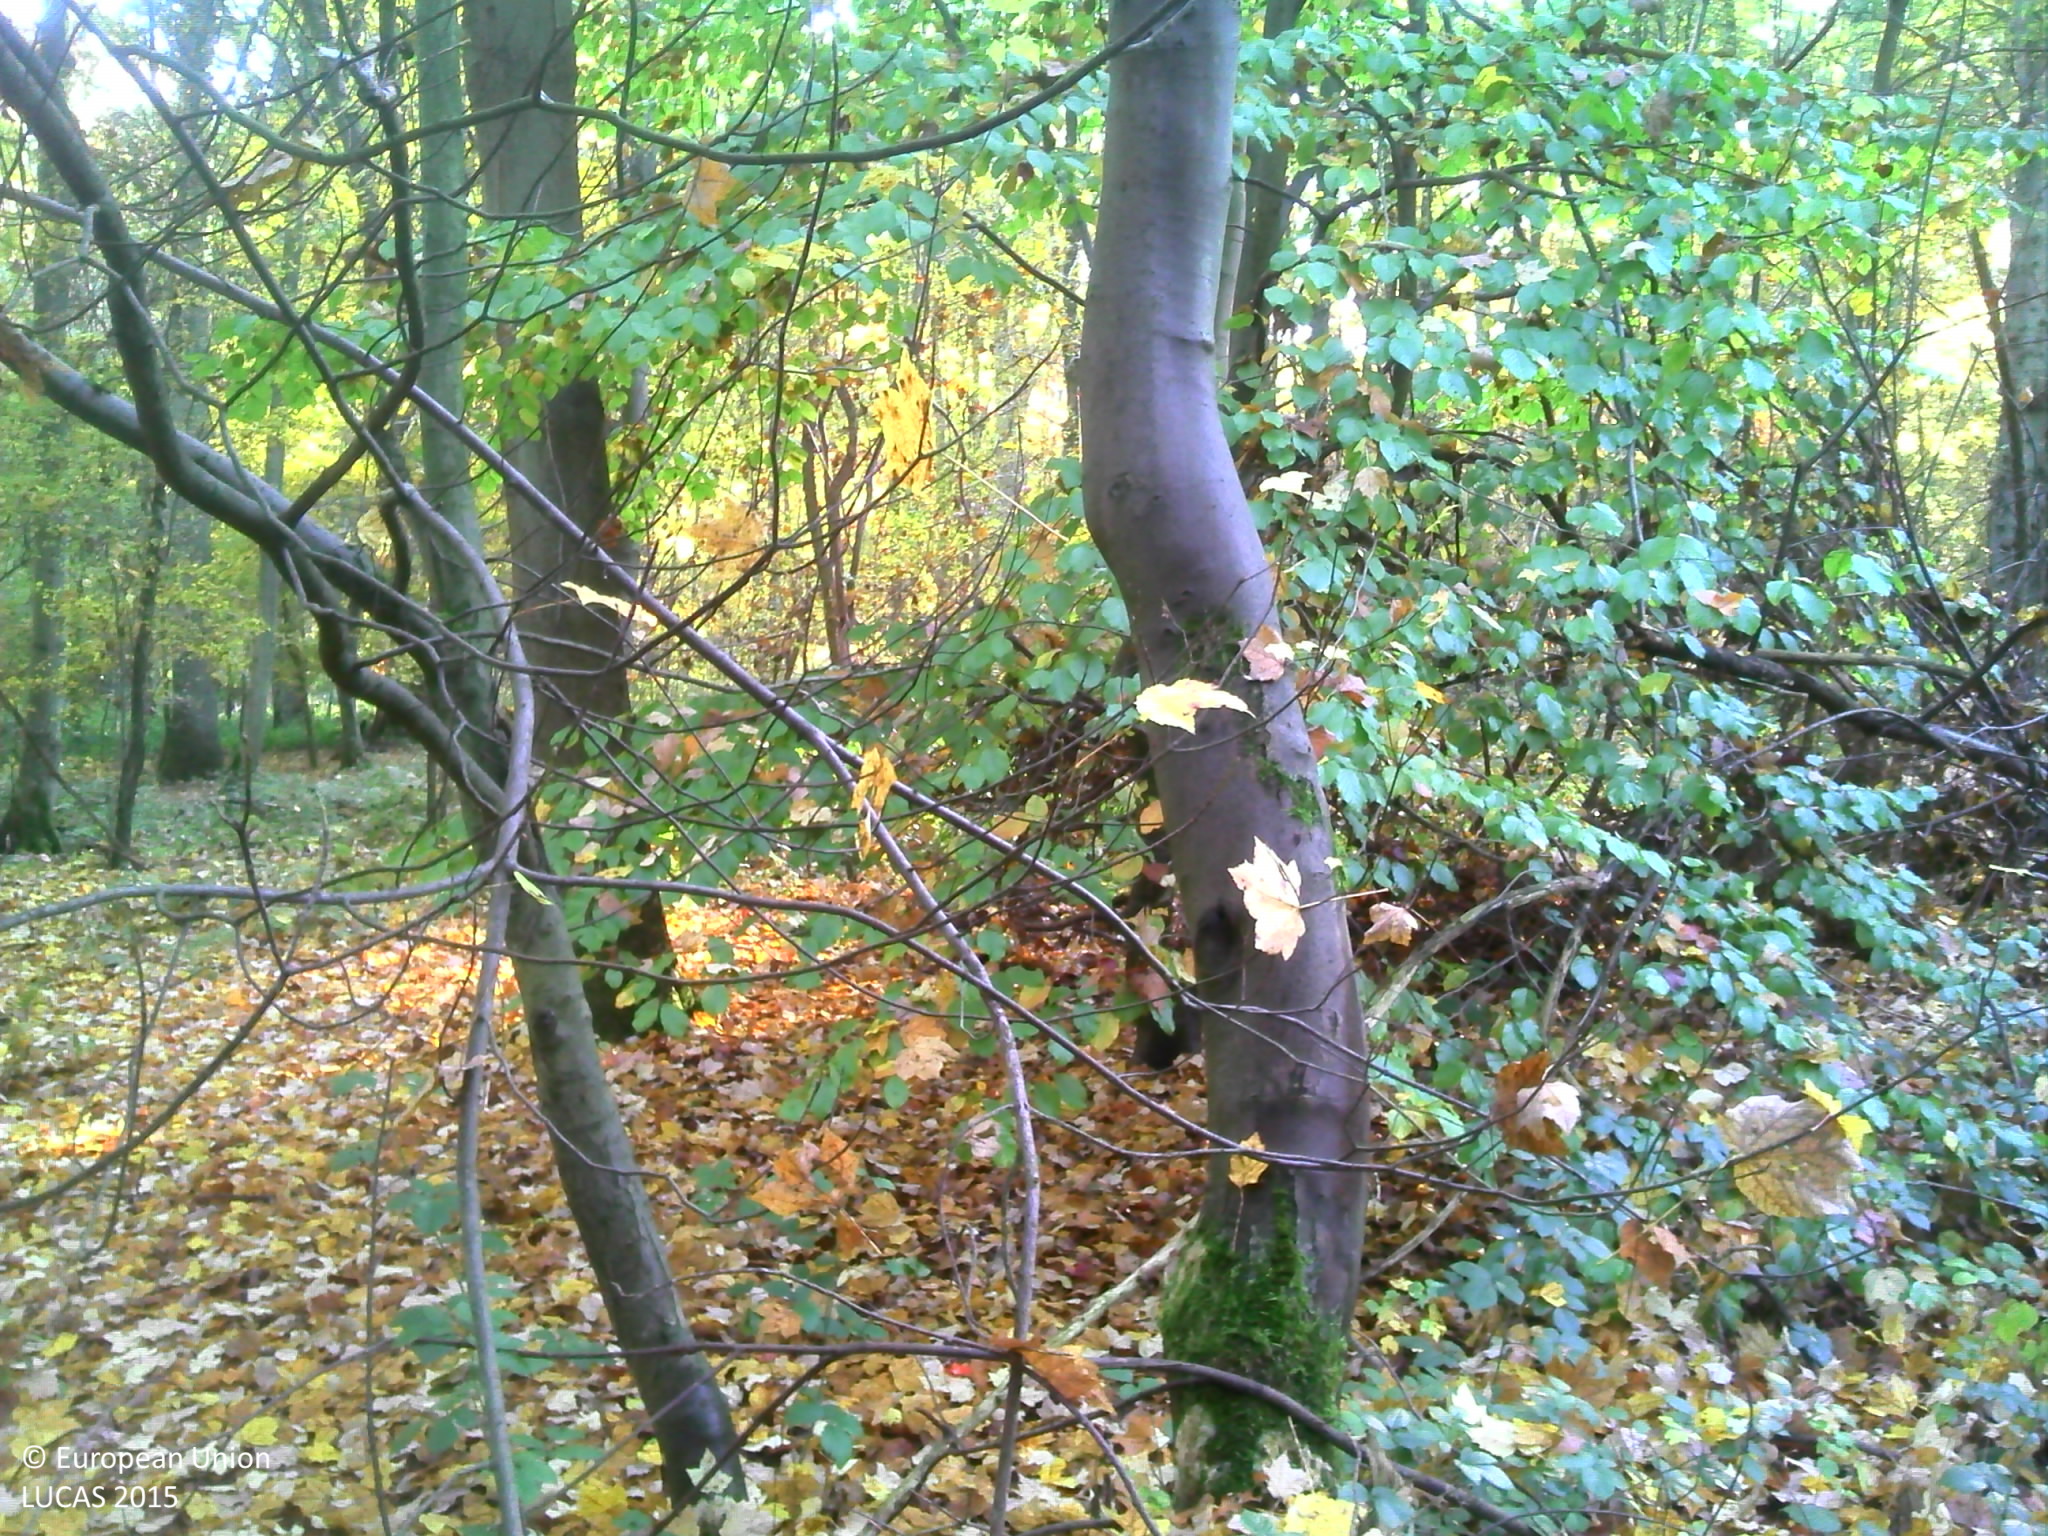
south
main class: Woodland
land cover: Broadleaved woodland
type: mesophytic deciduous forest
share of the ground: > 75 %
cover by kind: broadleaved forest trees 80 %, herbaceous plants 20 %
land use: Forestry
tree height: > 5 m
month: October
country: BE
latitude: 50.8087
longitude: 4.5038
